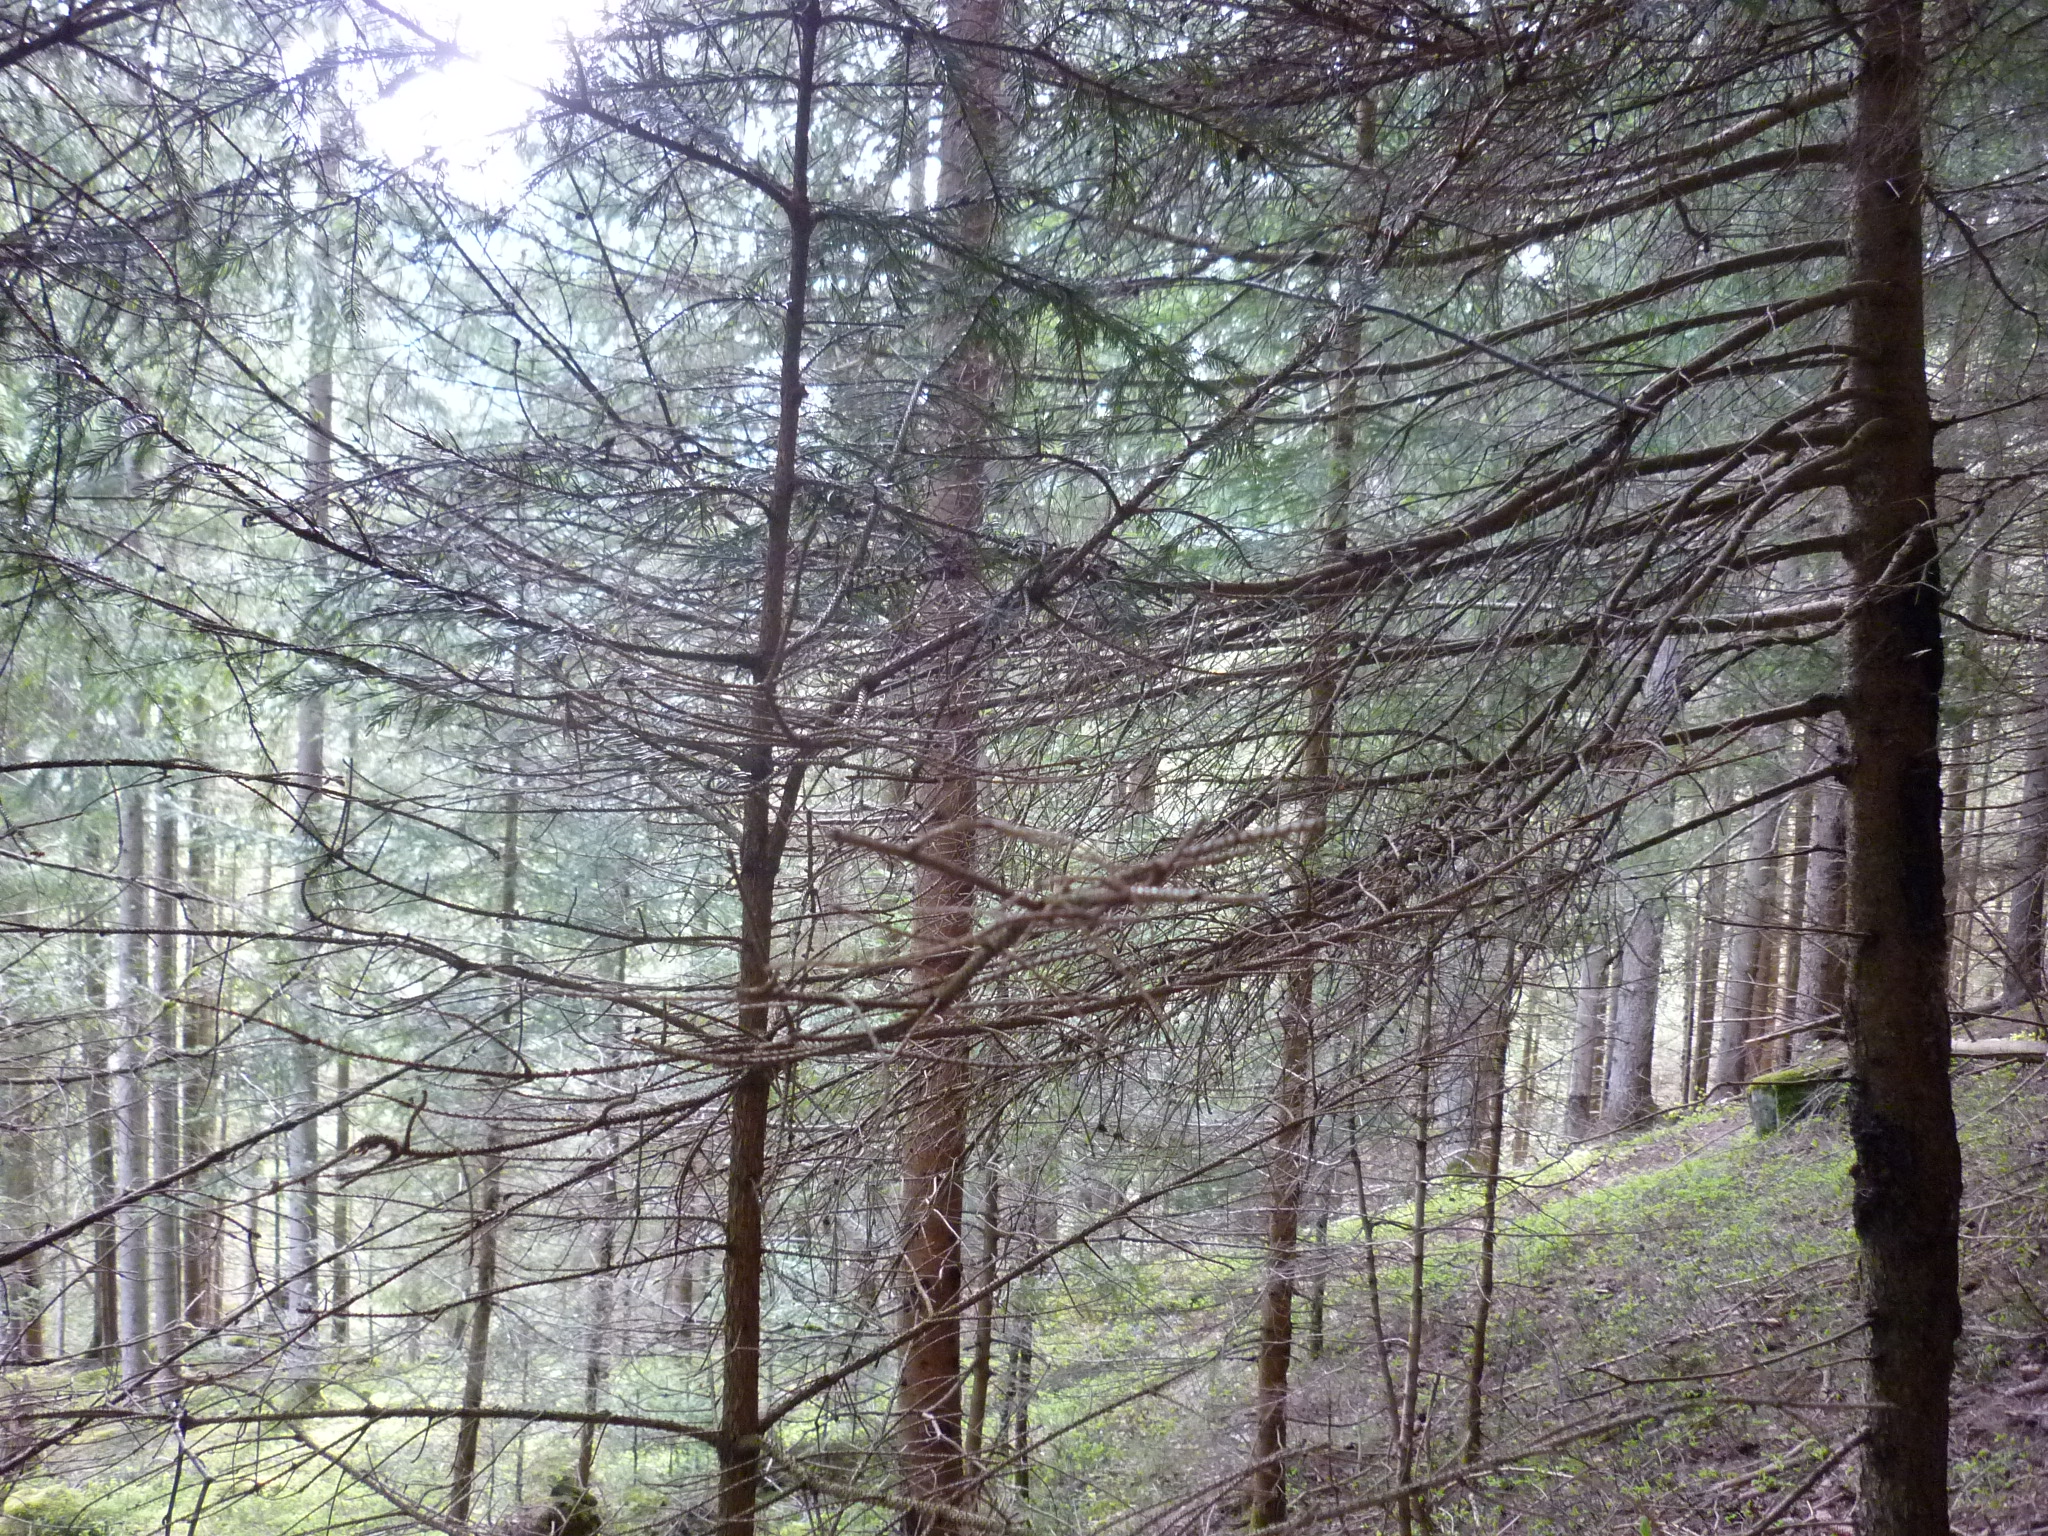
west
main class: Woodland
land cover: Spruce dominated coniferous woodland
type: alpine coniferous forest
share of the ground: > 75 %
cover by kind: coniferous forest trees 90 %, broadleaved forest trees 5 %, herbaceous plants 5 %
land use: Forestry
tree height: > 5 m
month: May
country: AT
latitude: 47.4925
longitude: 14.2596
